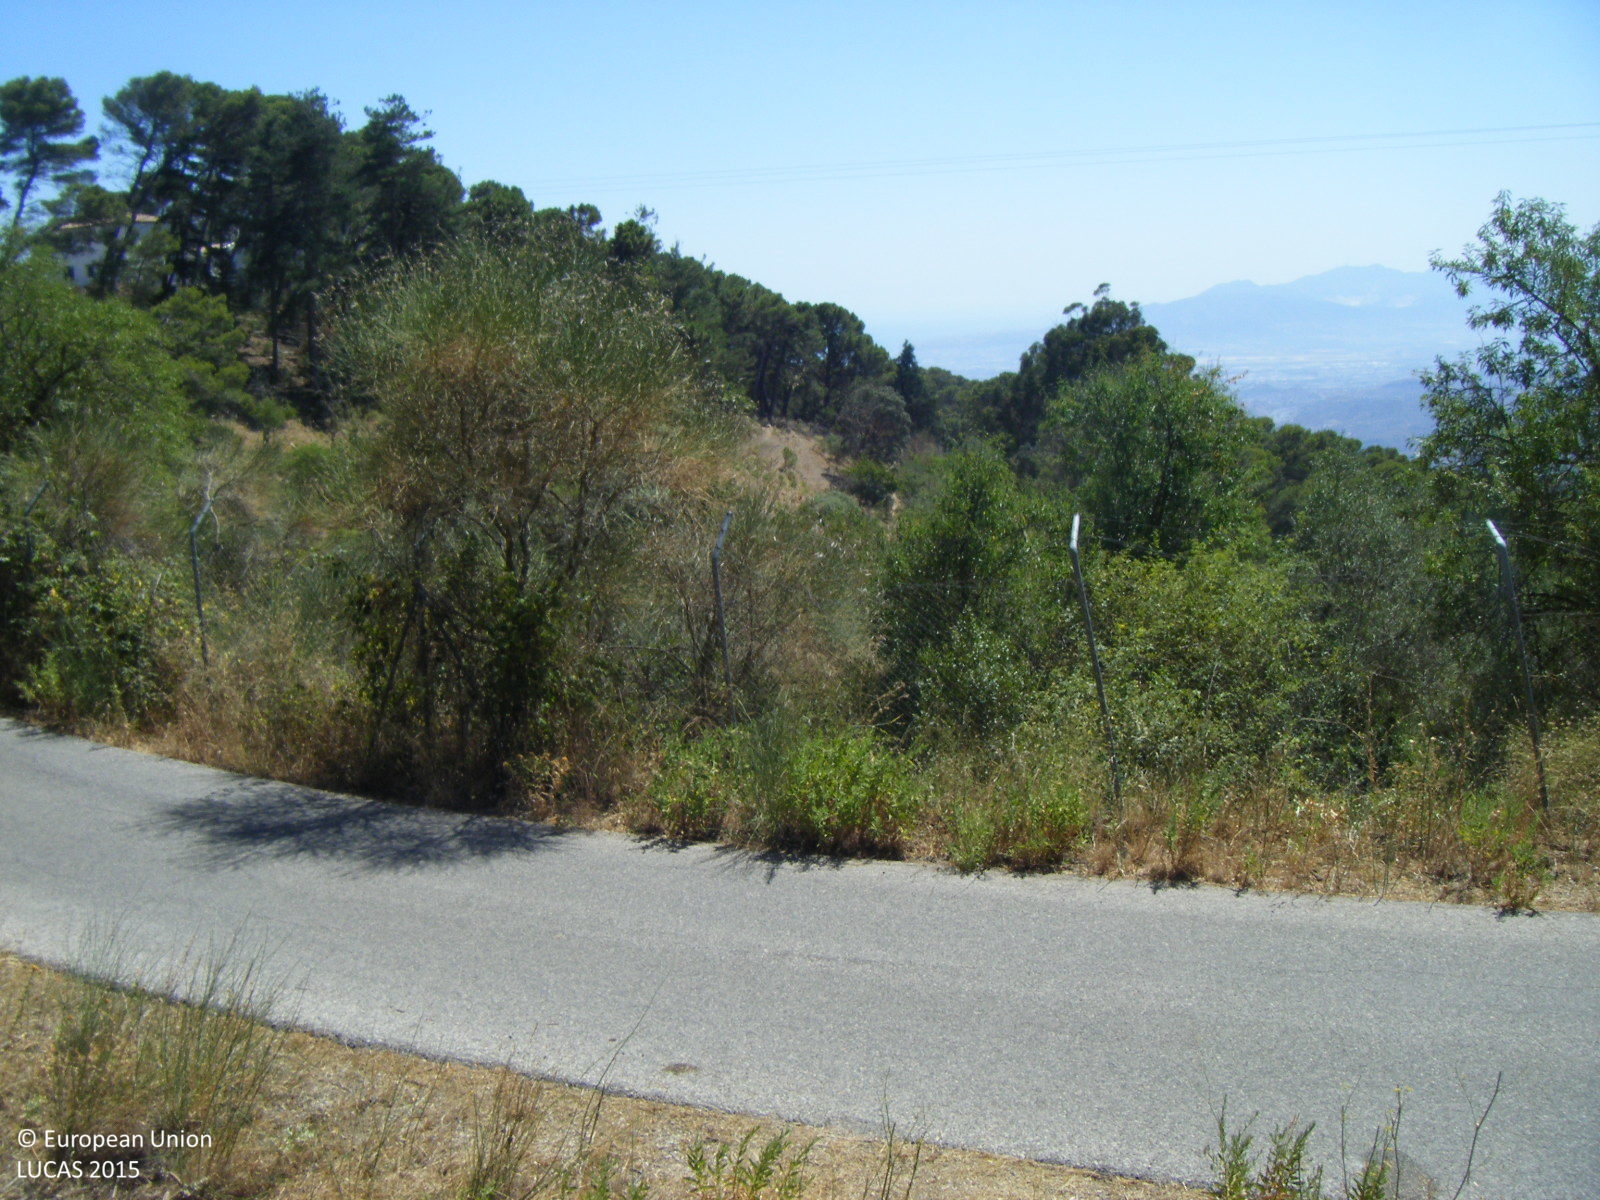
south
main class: Woodland
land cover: Pine dominated coniferous woodland
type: coniferous forest of the mediterranean region
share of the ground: 10 - 25 %
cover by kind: shrubs 80 %, coniferous forest trees 20 %
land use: Forestry
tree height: > 5 m
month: July
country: ES
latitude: 36.8150
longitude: -4.3733
